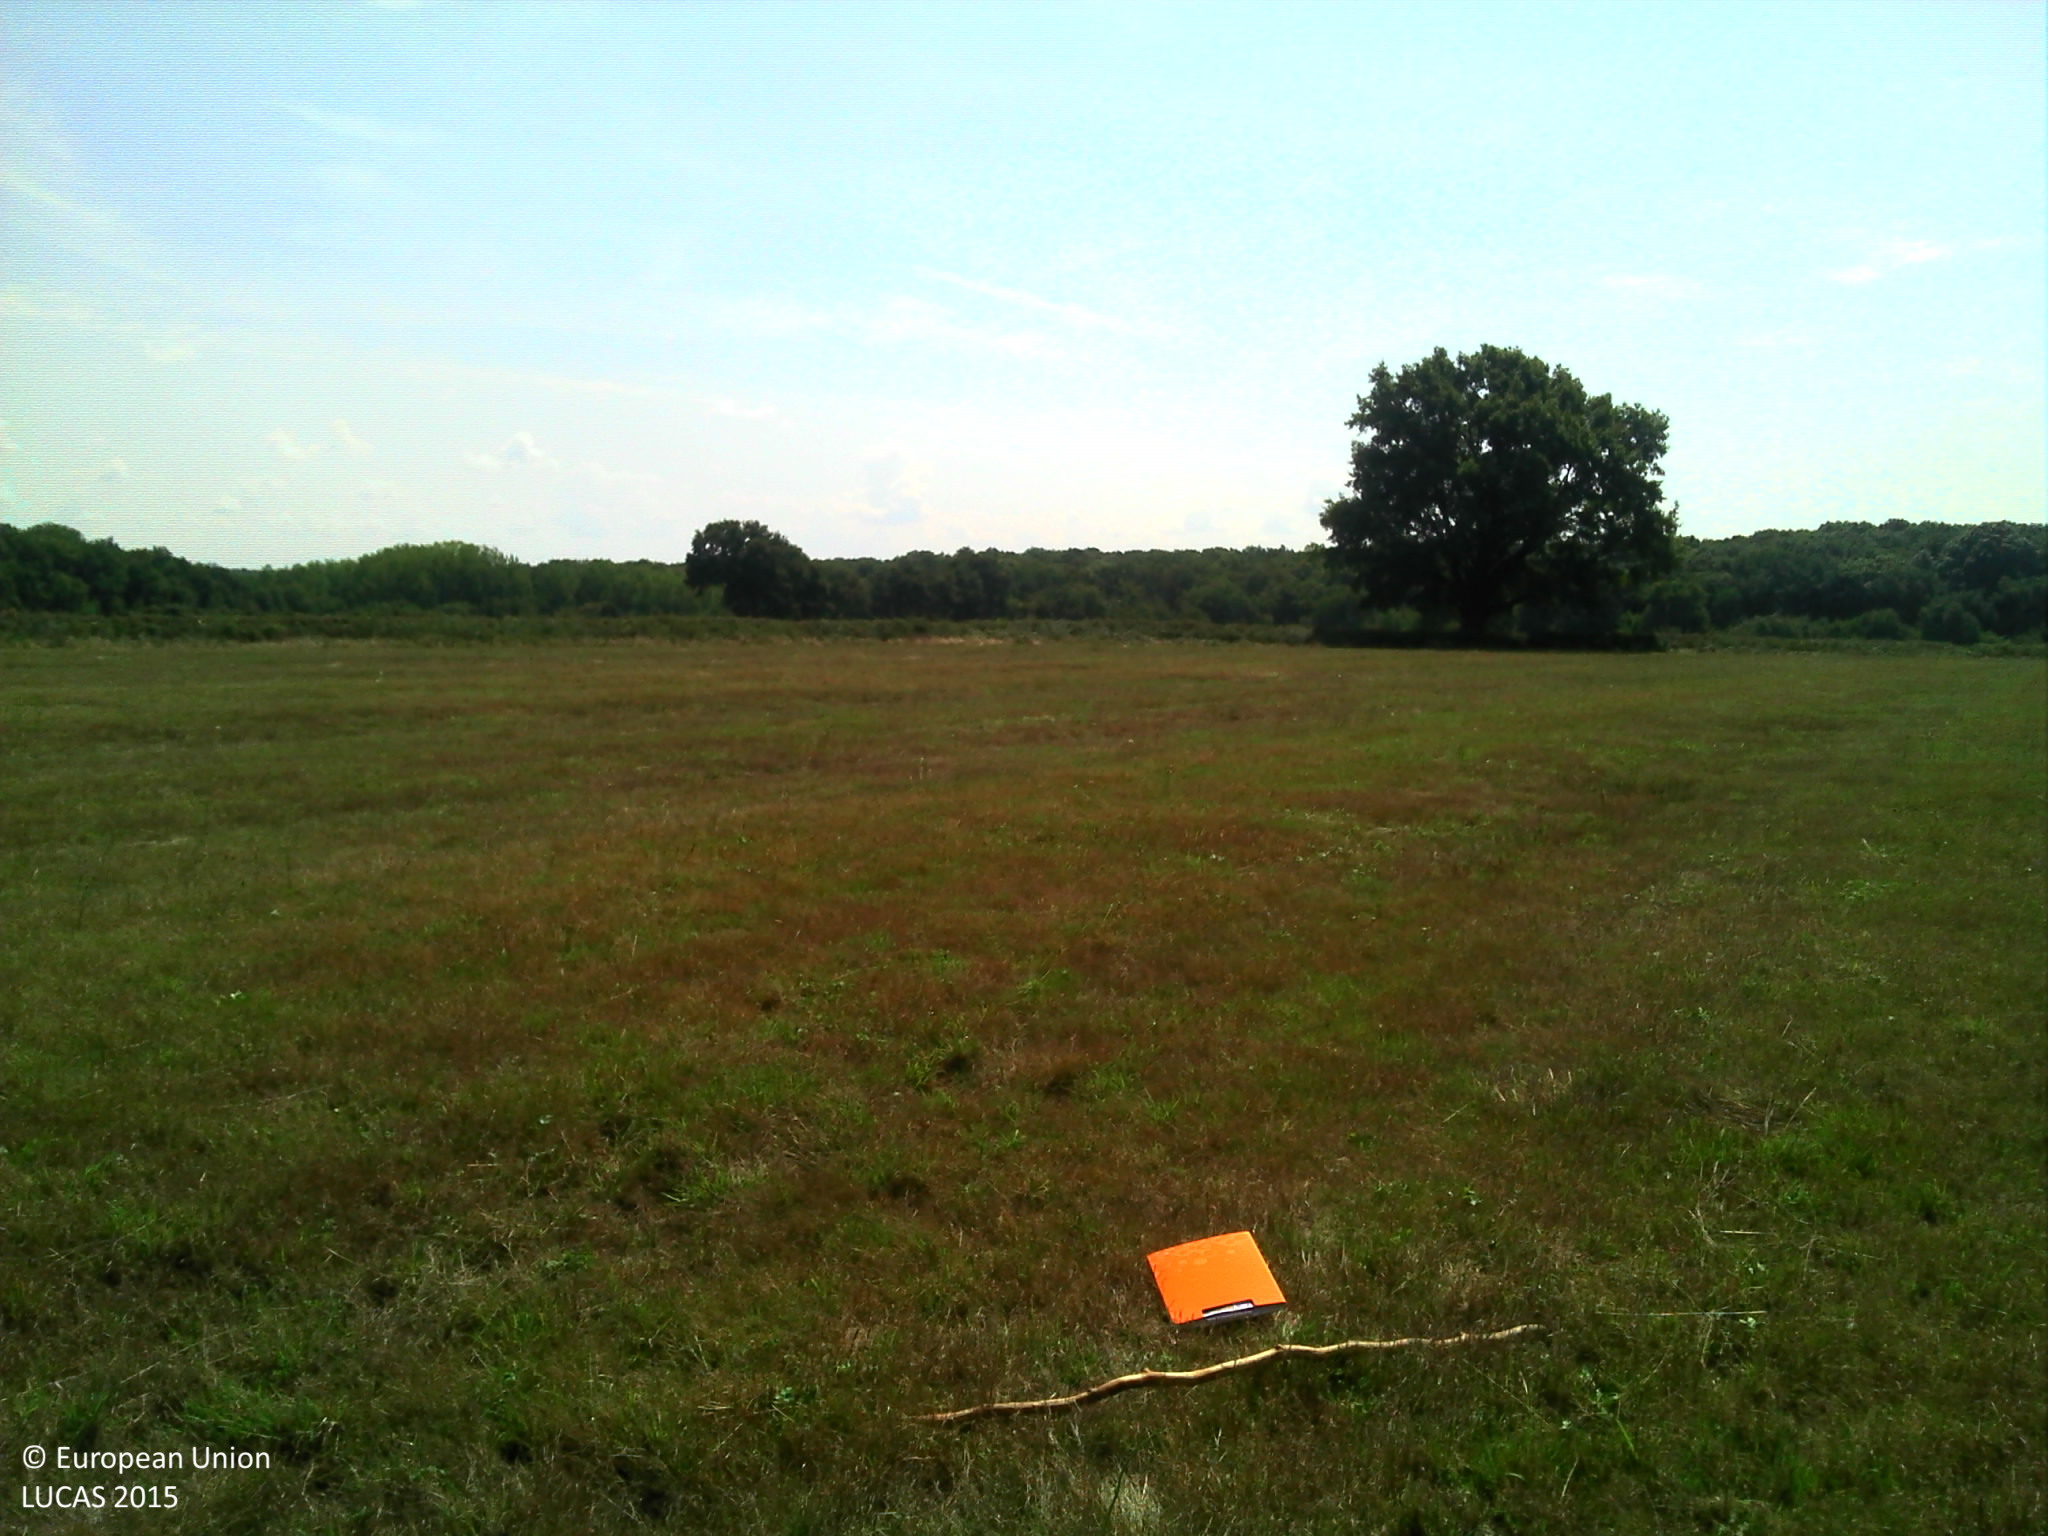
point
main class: Grassland
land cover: Grassland without tree/shrub cover
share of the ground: > 75 %
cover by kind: herbaceous plants 100 %
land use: Agriculture (excluding fallow land and kitchen gardens)
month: August
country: FR
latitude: 46.5359
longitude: 3.2569
